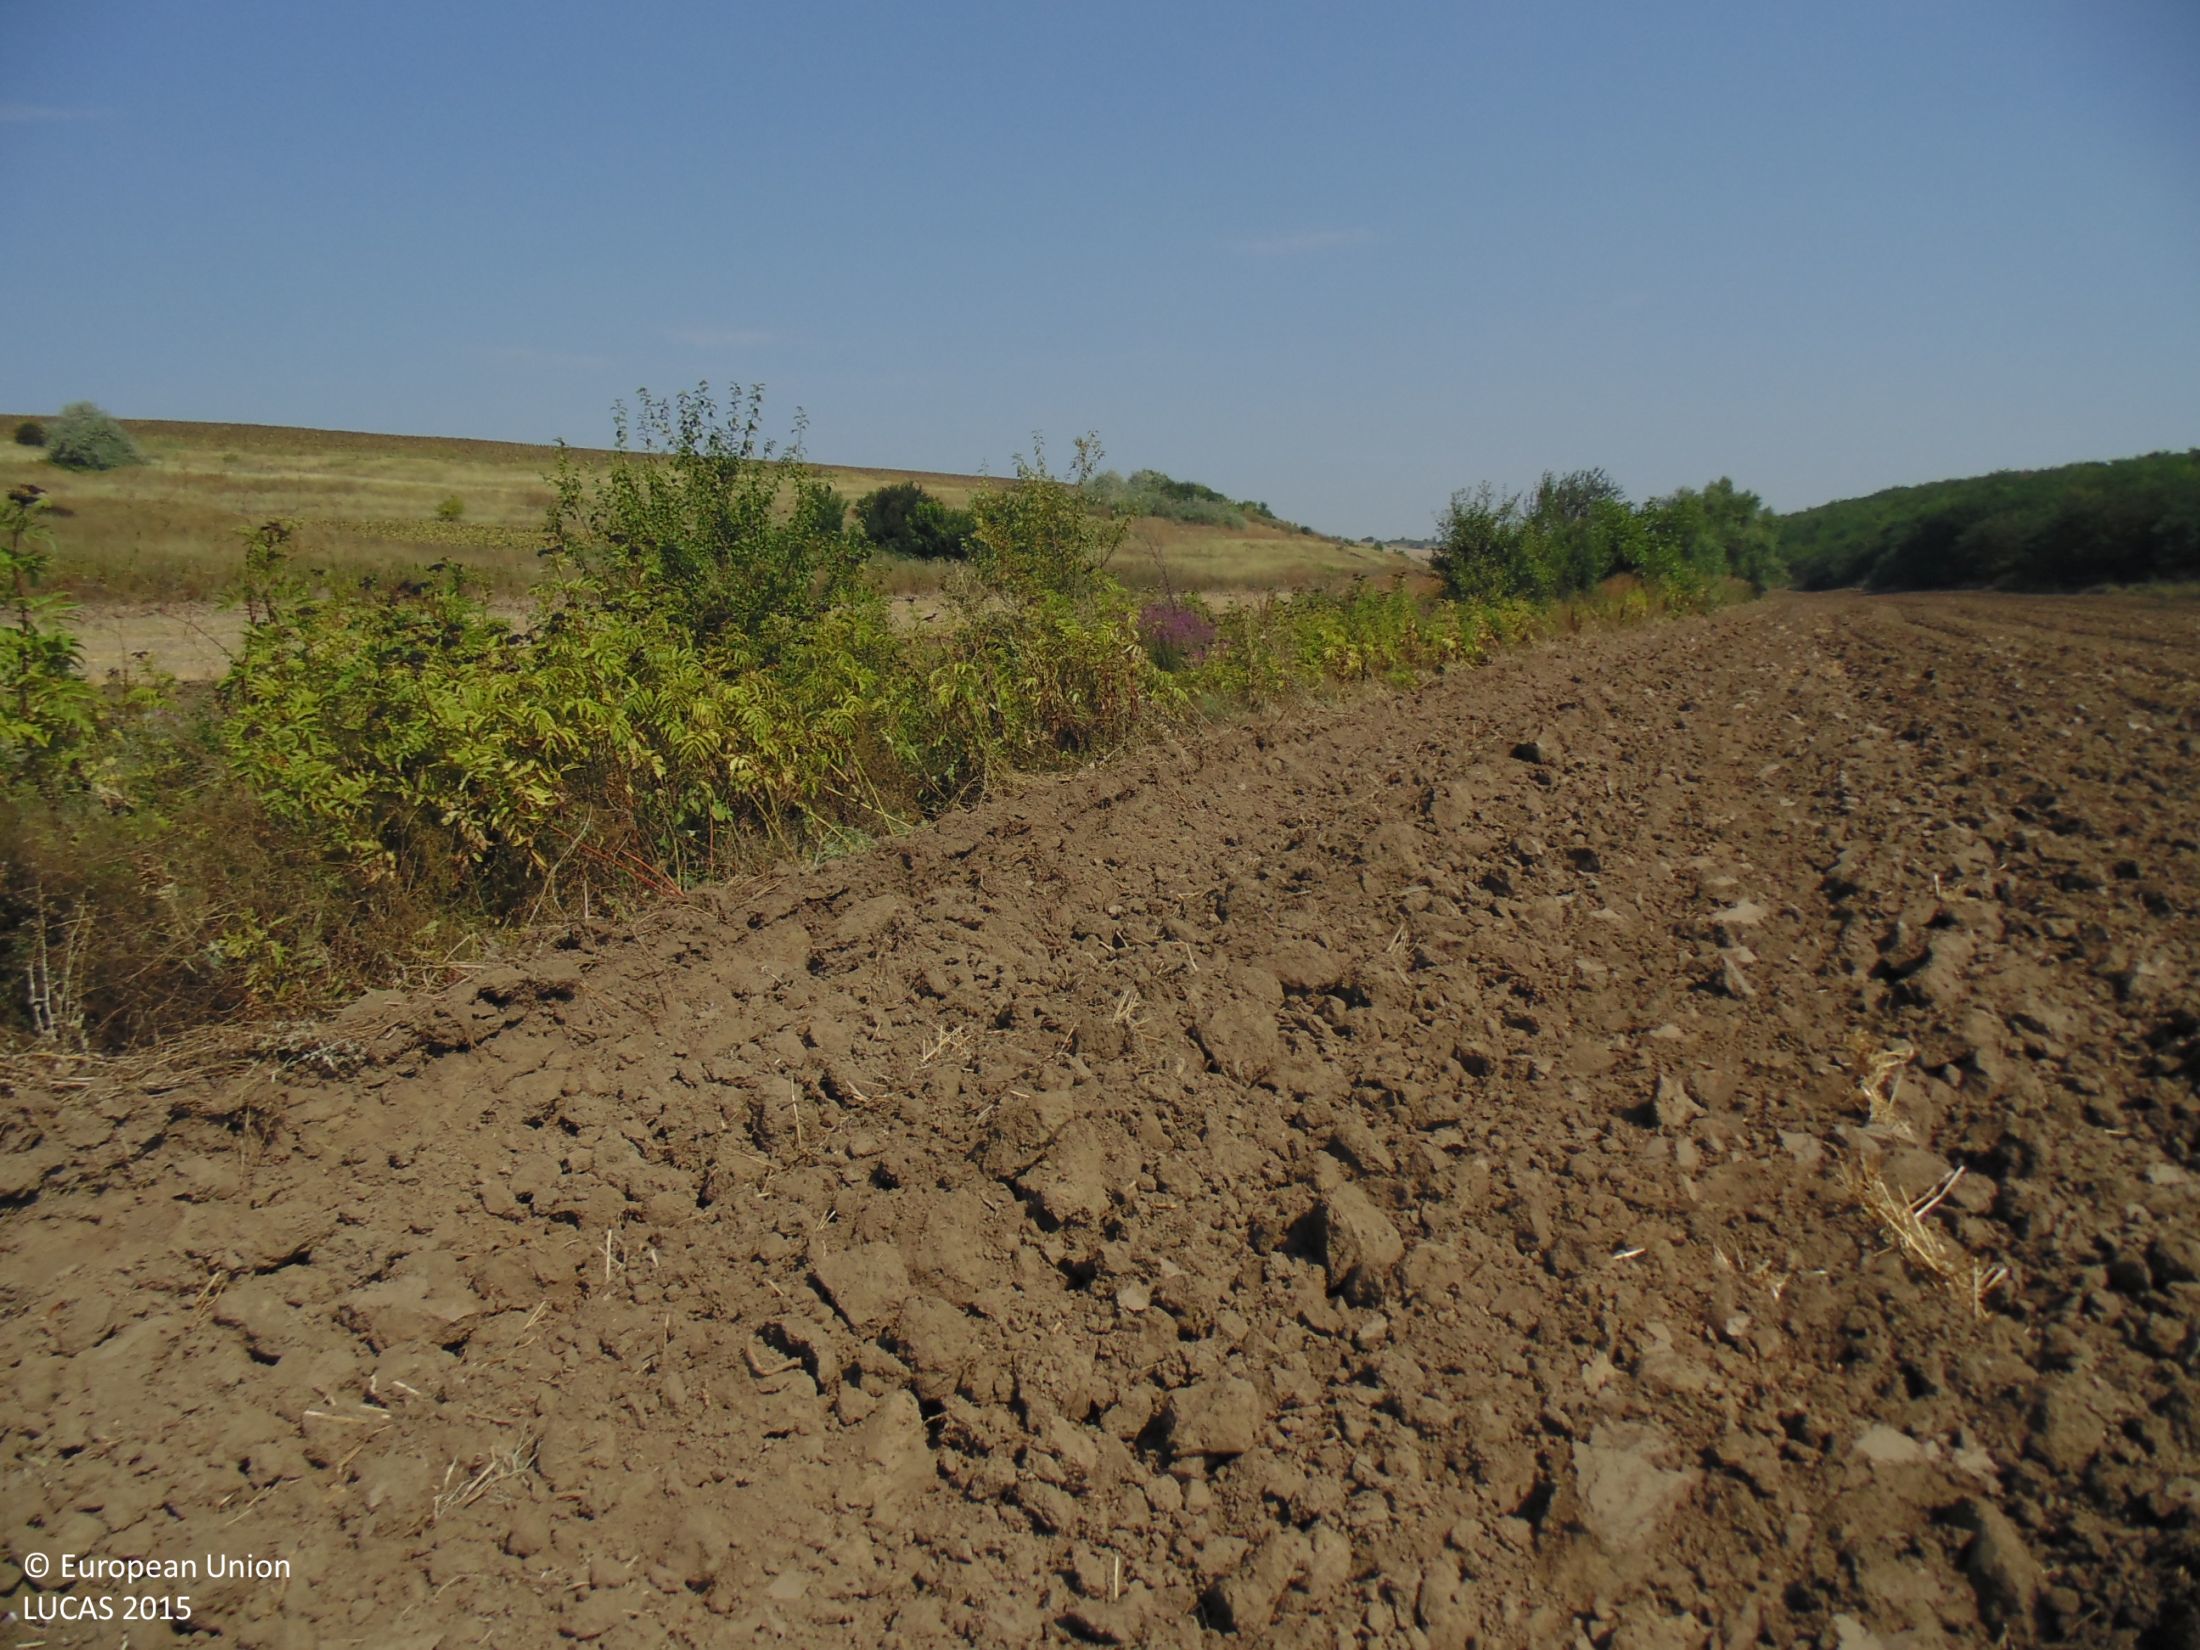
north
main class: Cropland
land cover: Common wheat
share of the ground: < 10 %
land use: Agriculture (excluding fallow land and kitchen gardens)
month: August
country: BG
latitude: 44.0412
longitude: 27.3167
